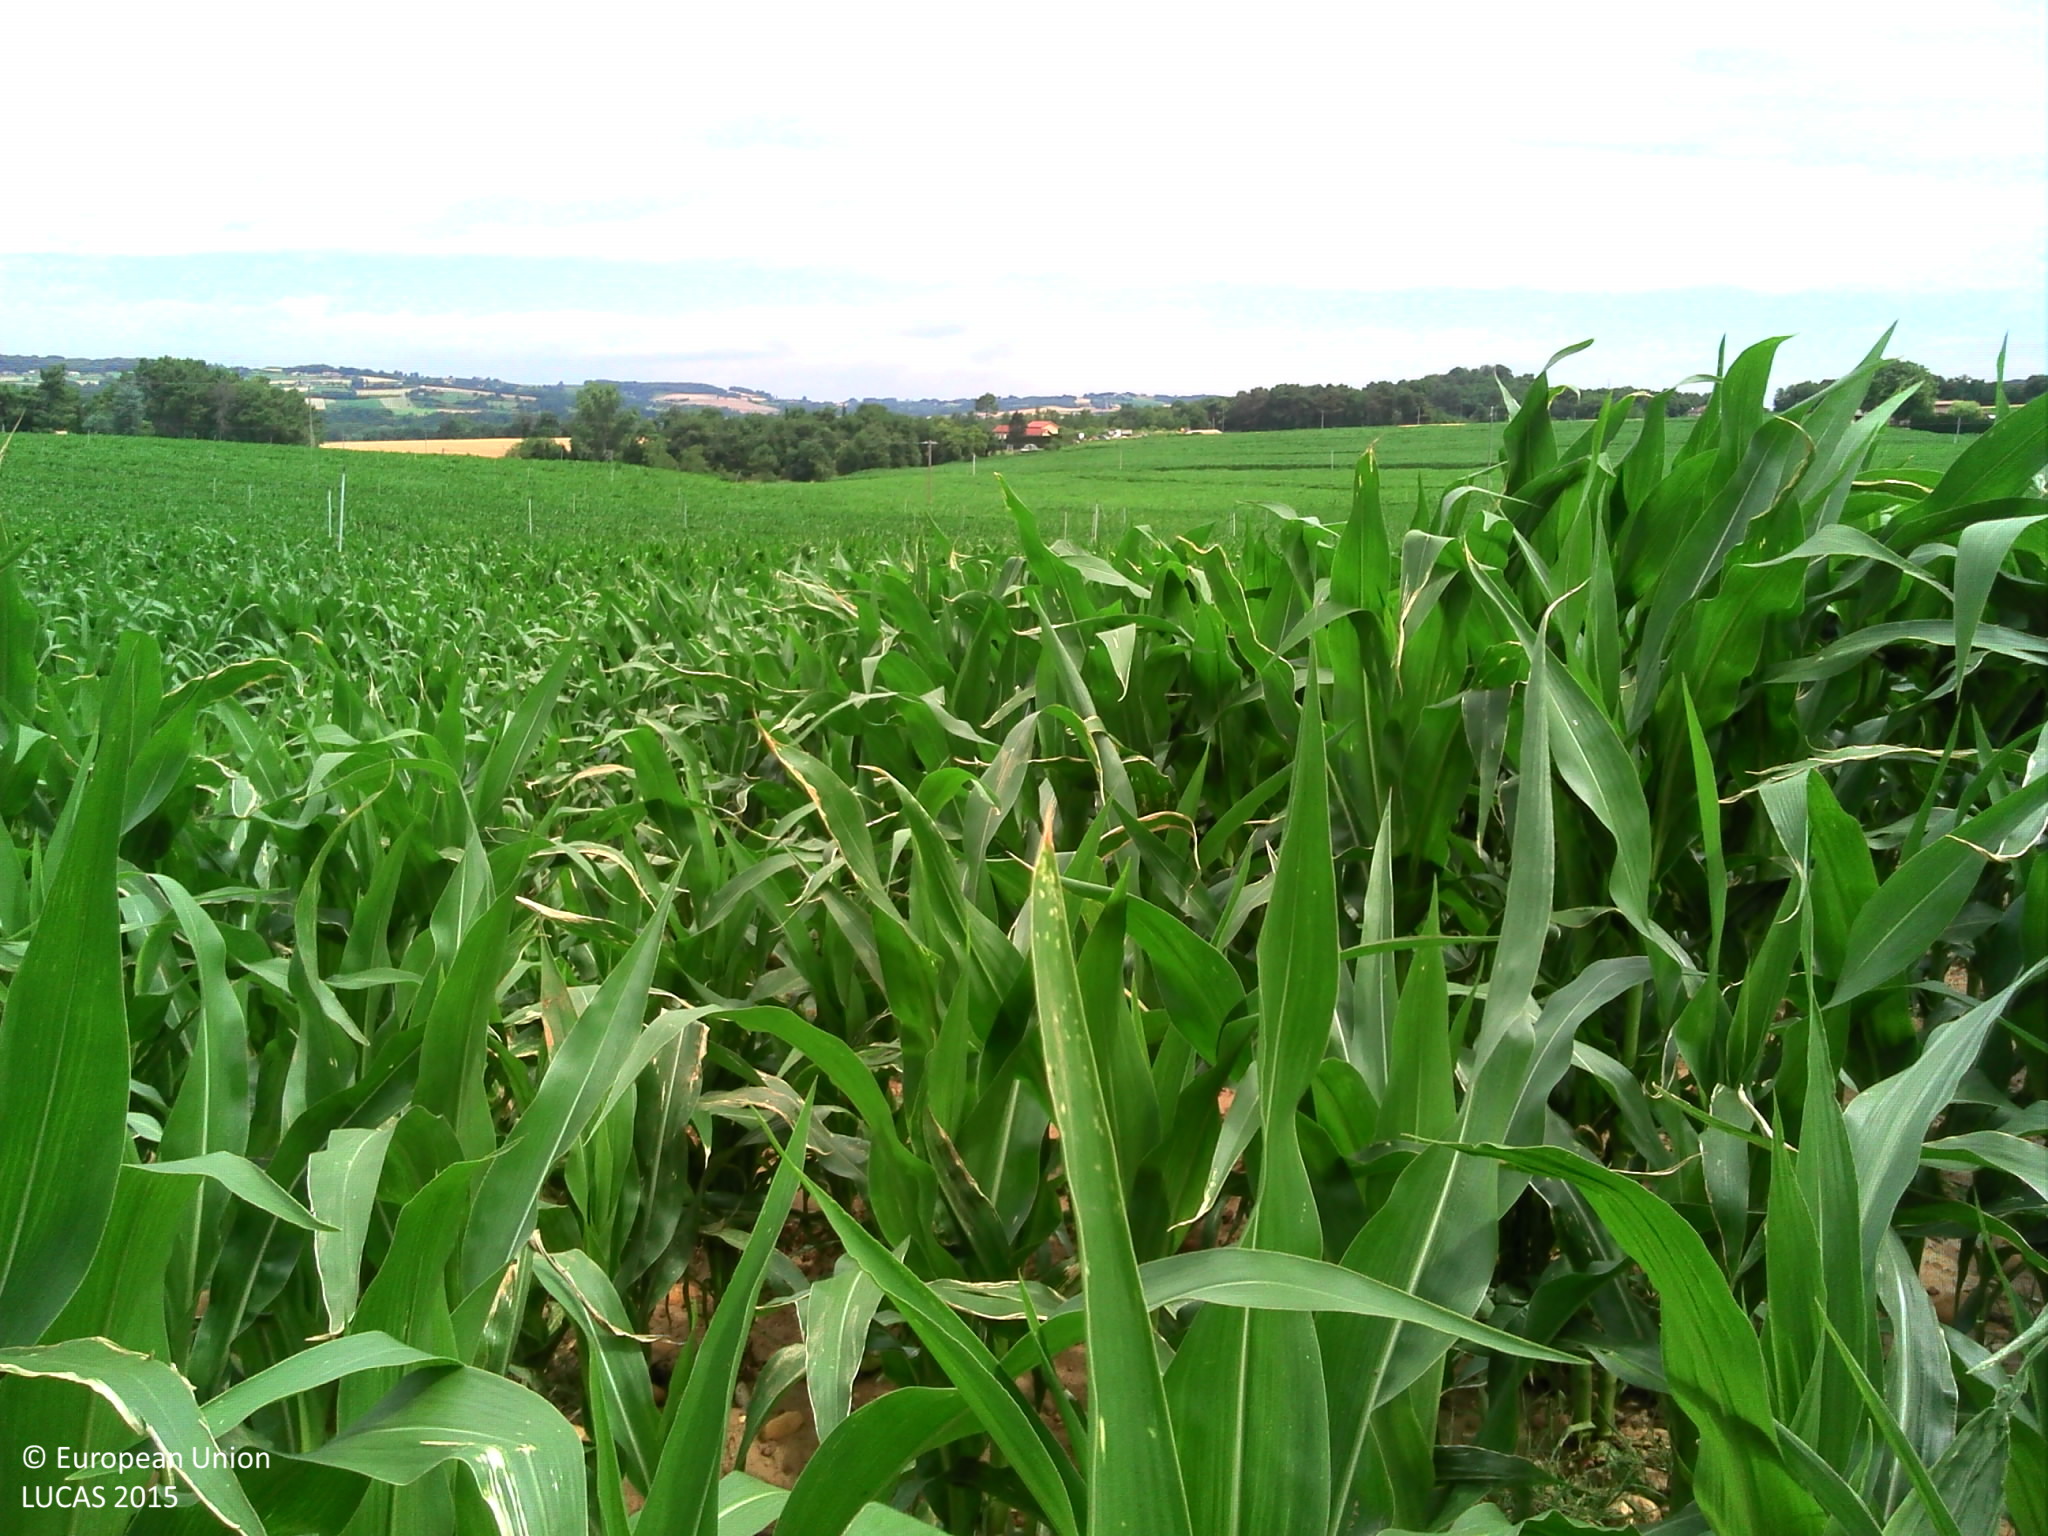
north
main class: Cropland
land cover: Maize
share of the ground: > 75 %
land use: Agriculture (excluding fallow land and kitchen gardens)
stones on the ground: 25 - 50 %
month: June
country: FR
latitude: 45.1647
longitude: 4.9035
